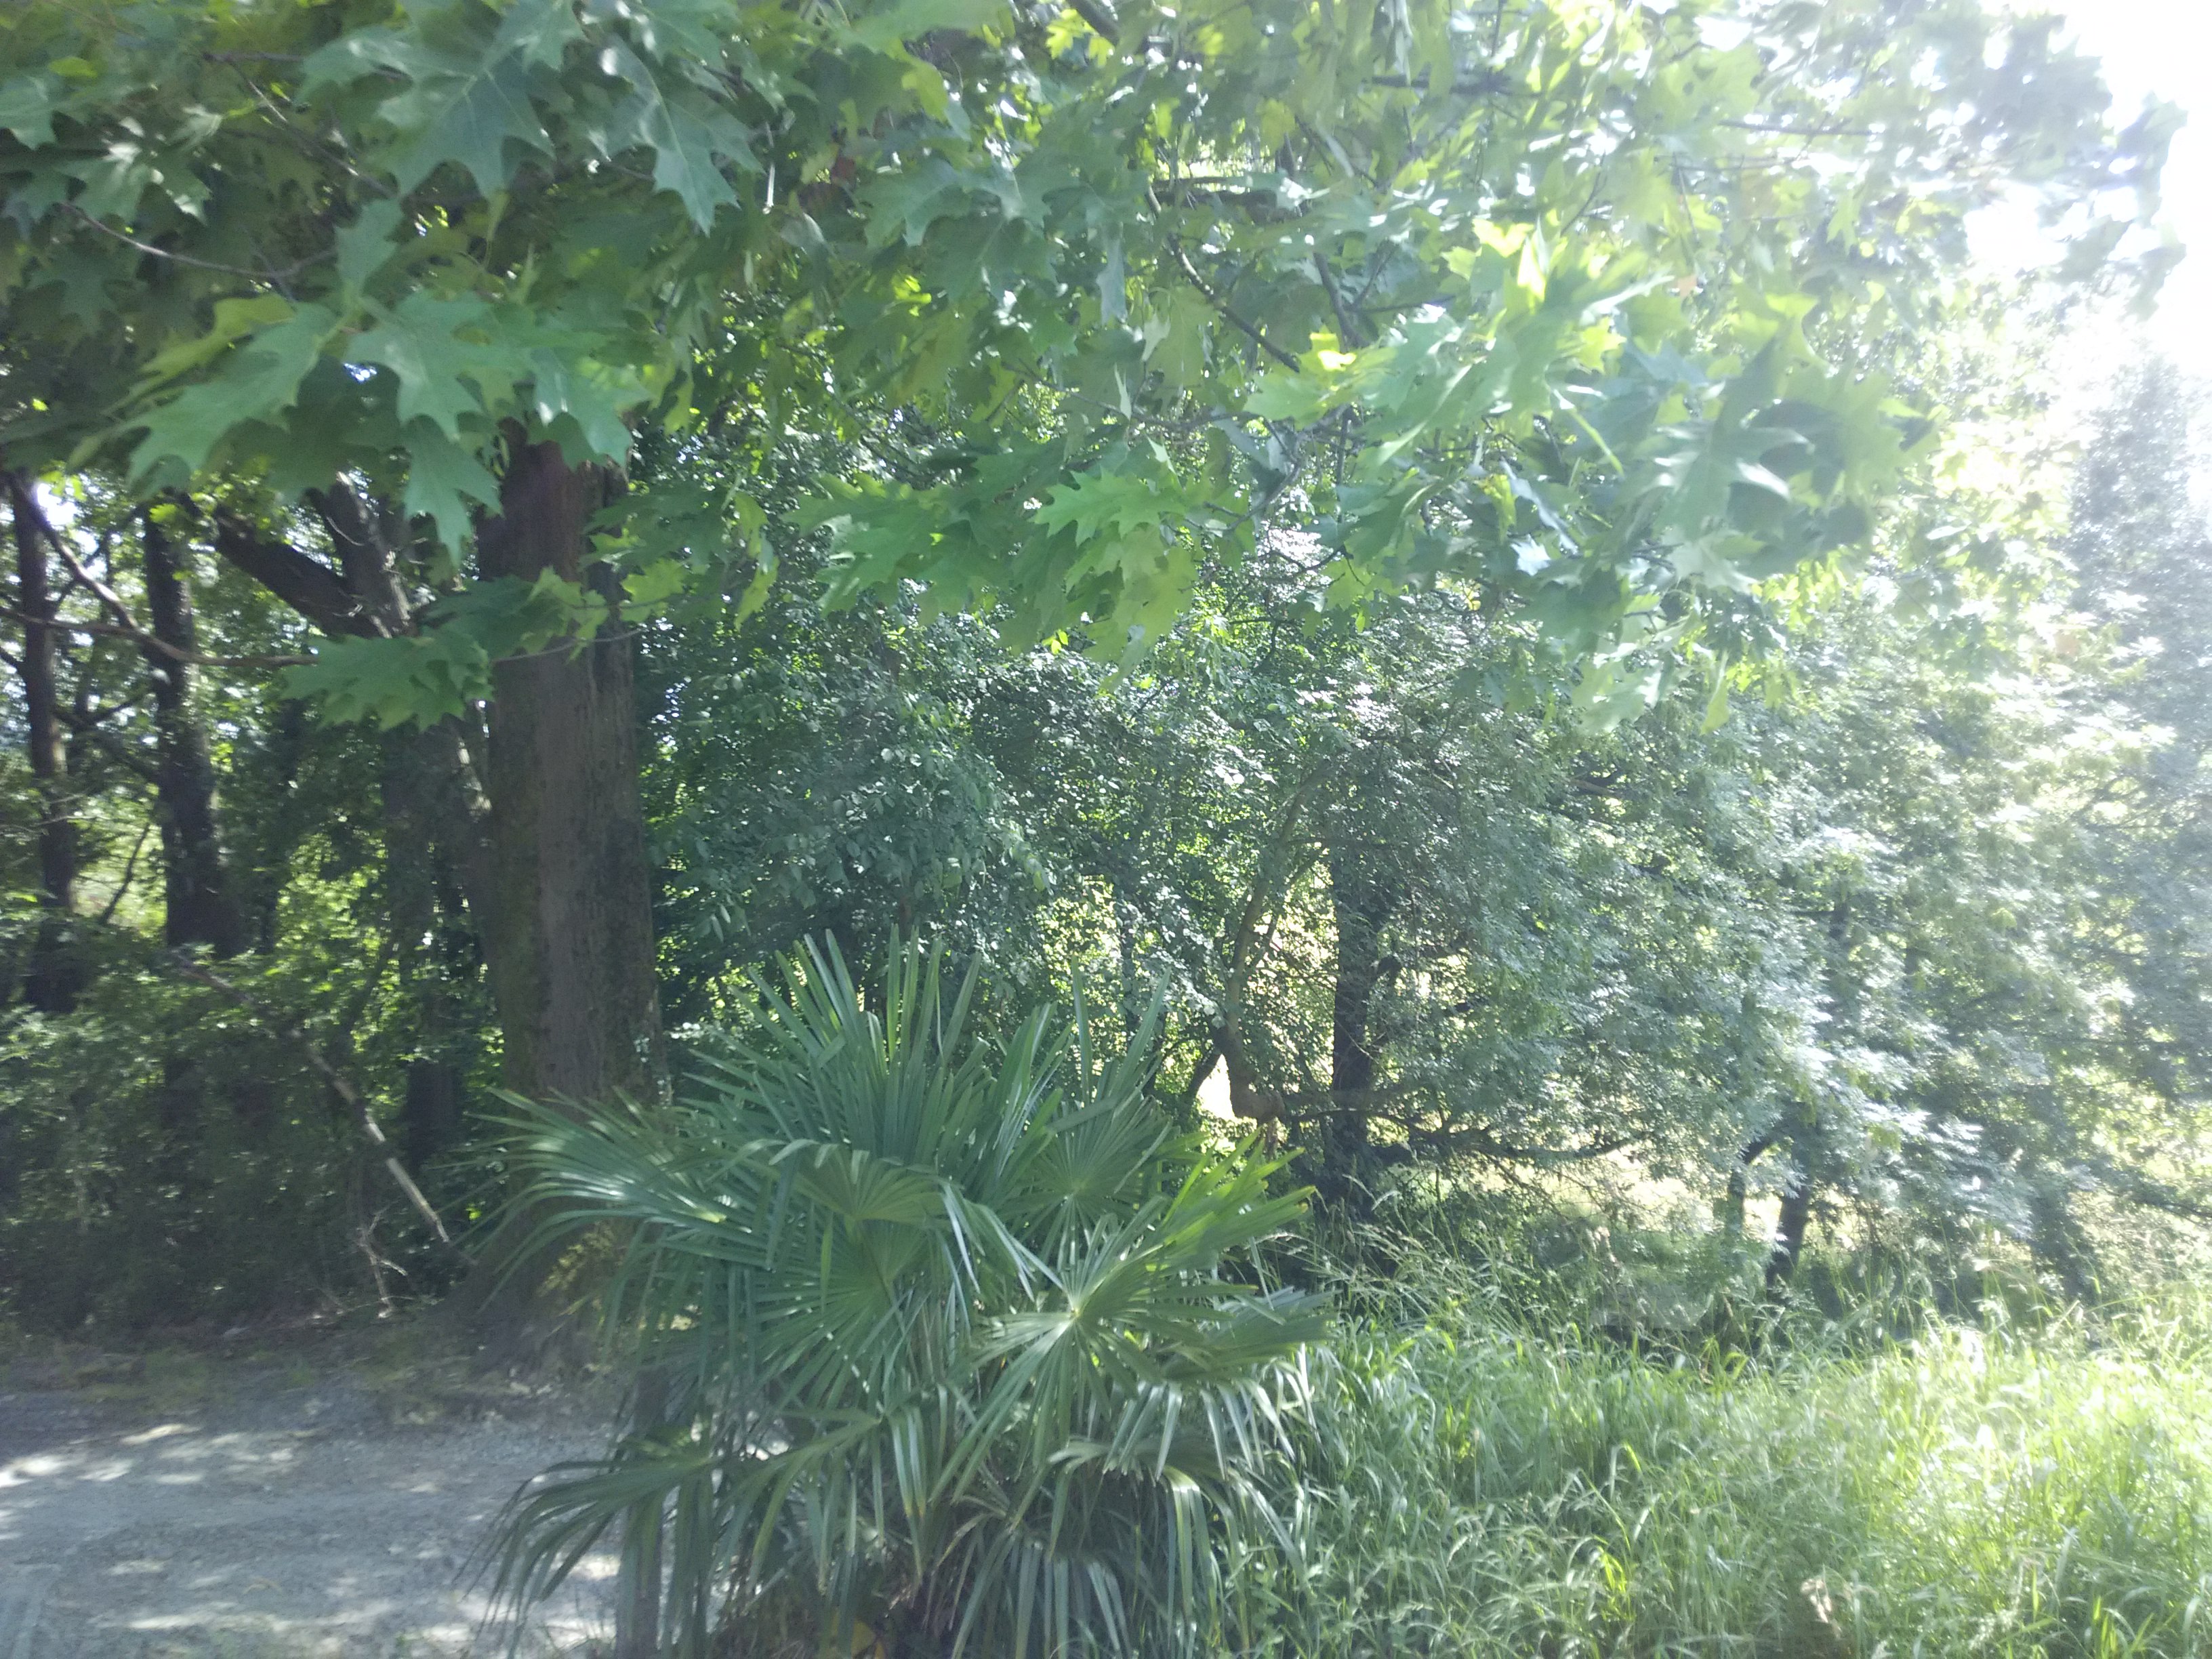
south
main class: Woodland
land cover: Broadleaved woodland
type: acidophilous oak and oak-birch forest
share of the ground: > 75 %
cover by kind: broadleaved forest trees 95 %, herbaceous plants 5 %
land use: Forestry
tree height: > 5 m
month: June
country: ES
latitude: 43.3204
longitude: -1.8713
